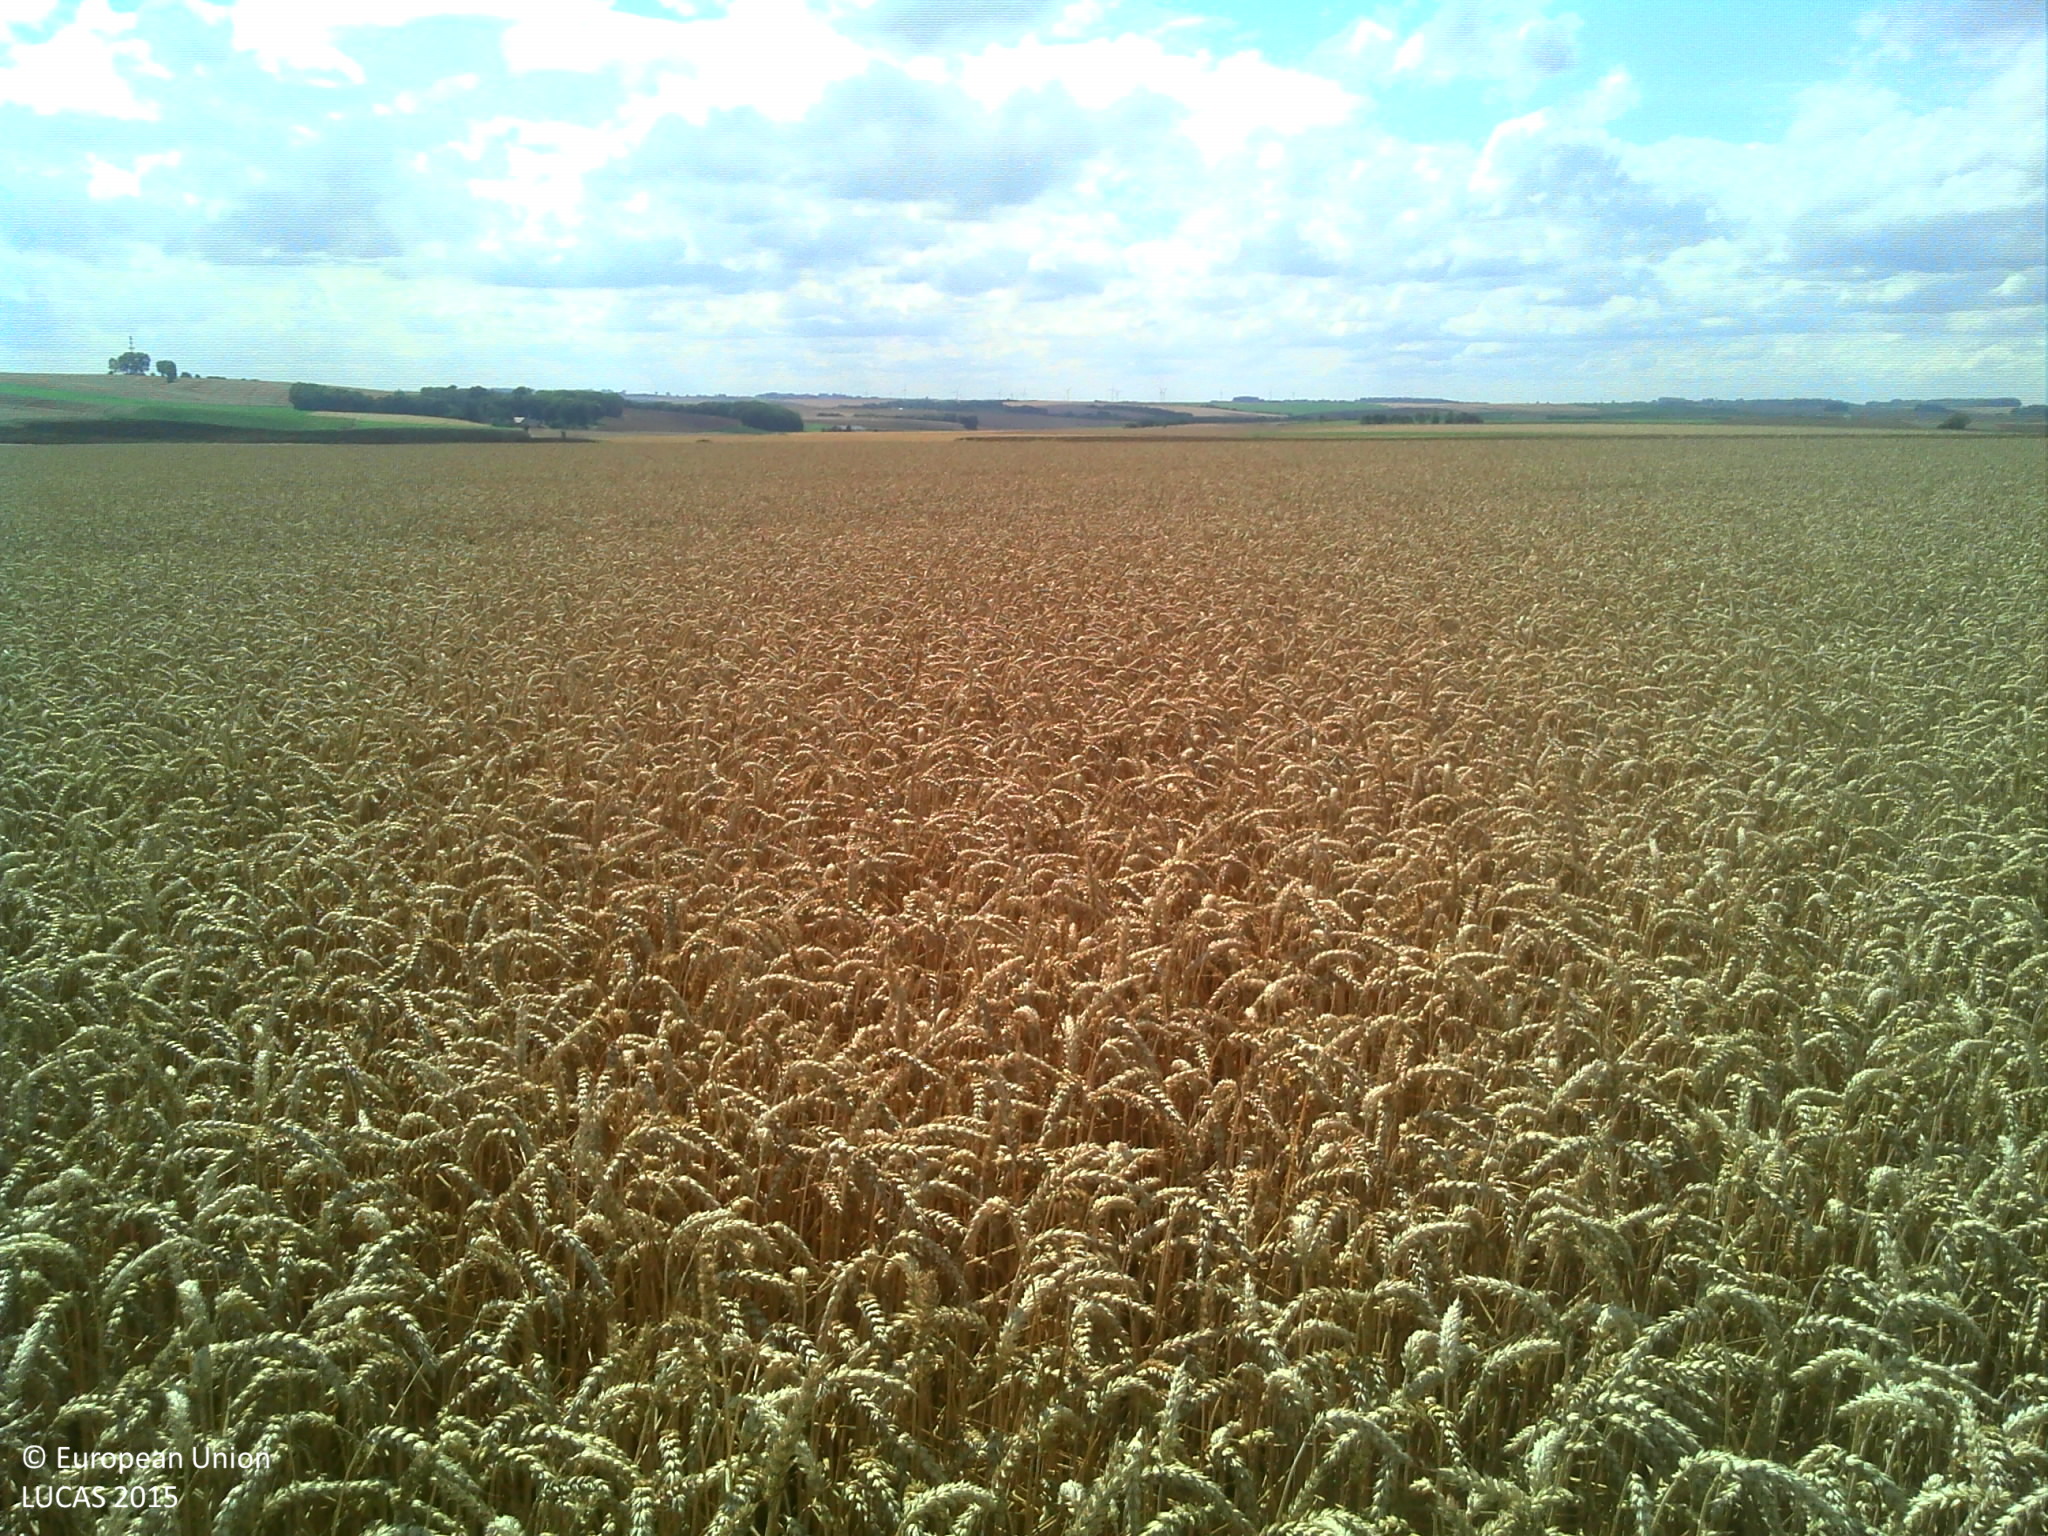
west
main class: Cropland
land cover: Common wheat
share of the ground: > 75 %
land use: Agriculture (excluding fallow land and kitchen gardens)
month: July
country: FR
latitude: 49.7547
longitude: 3.6499
